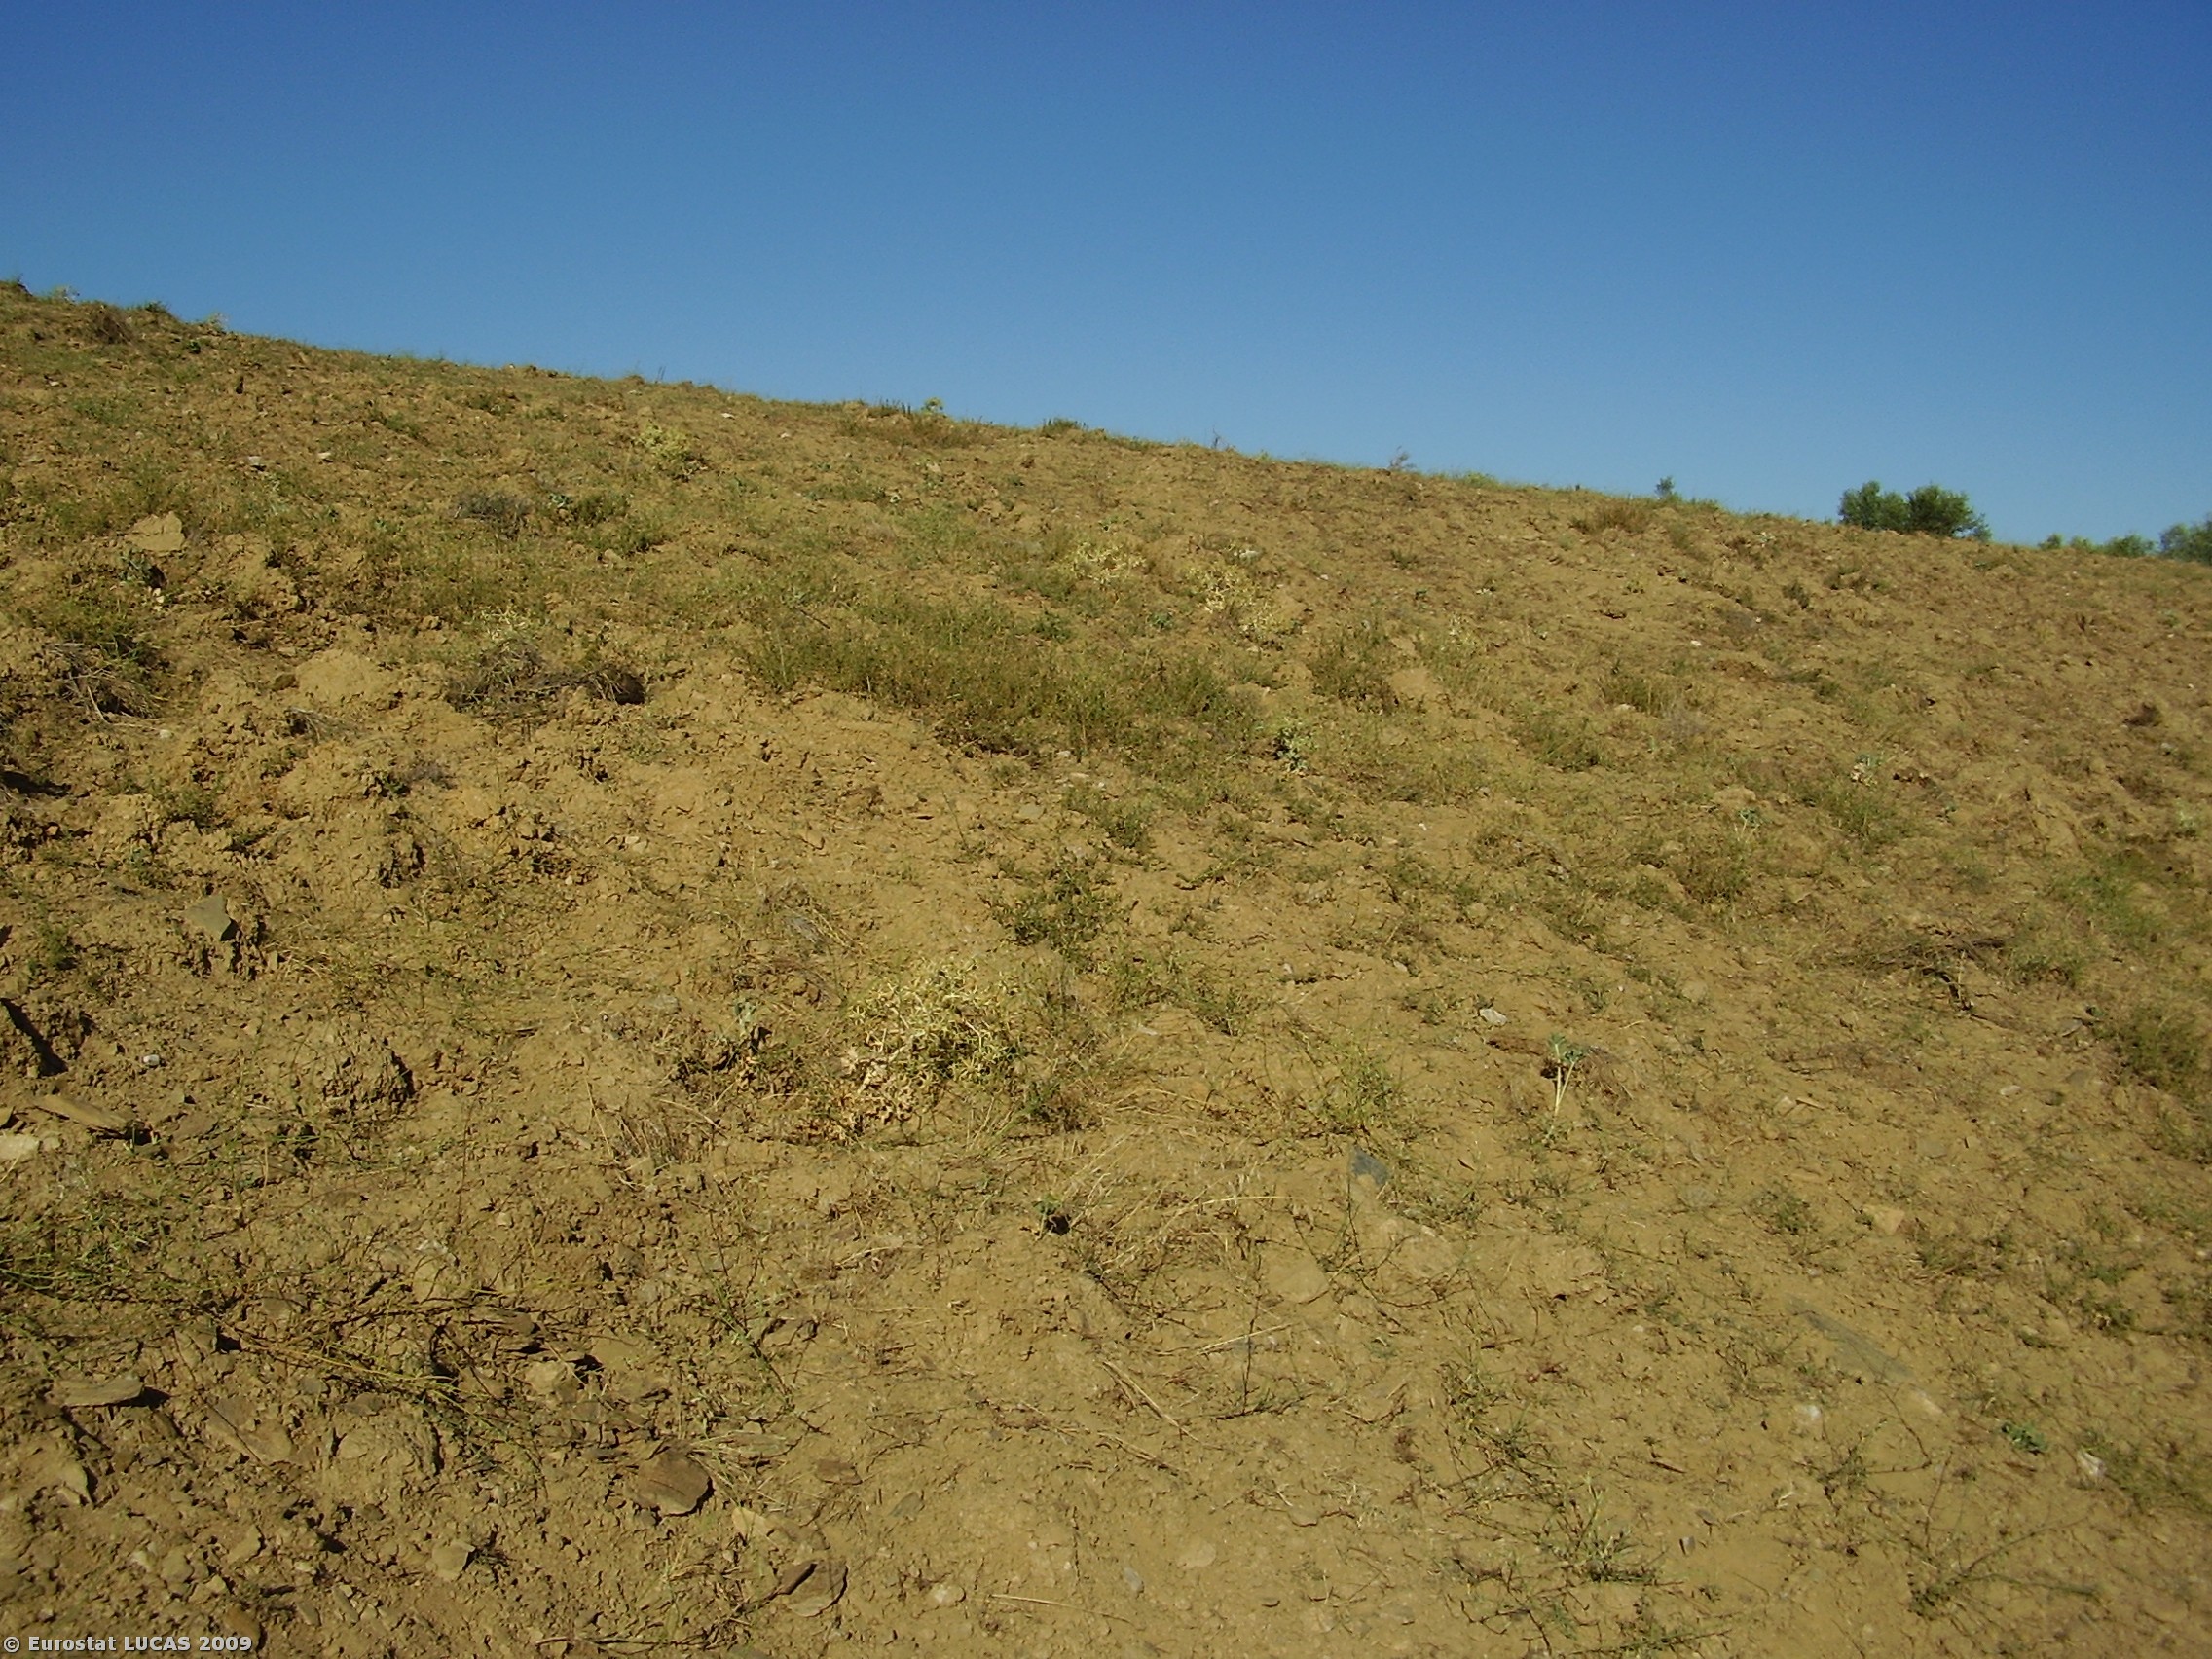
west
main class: Cropland
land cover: Olive groves
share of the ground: 10 - 25 %
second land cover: Spontaneously vegetated surfaces
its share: < 10 %
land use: Agriculture (excluding fallow land and kitchen gardens)
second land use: Fallow land
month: August
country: PT
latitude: 41.4270
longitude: -6.7768
